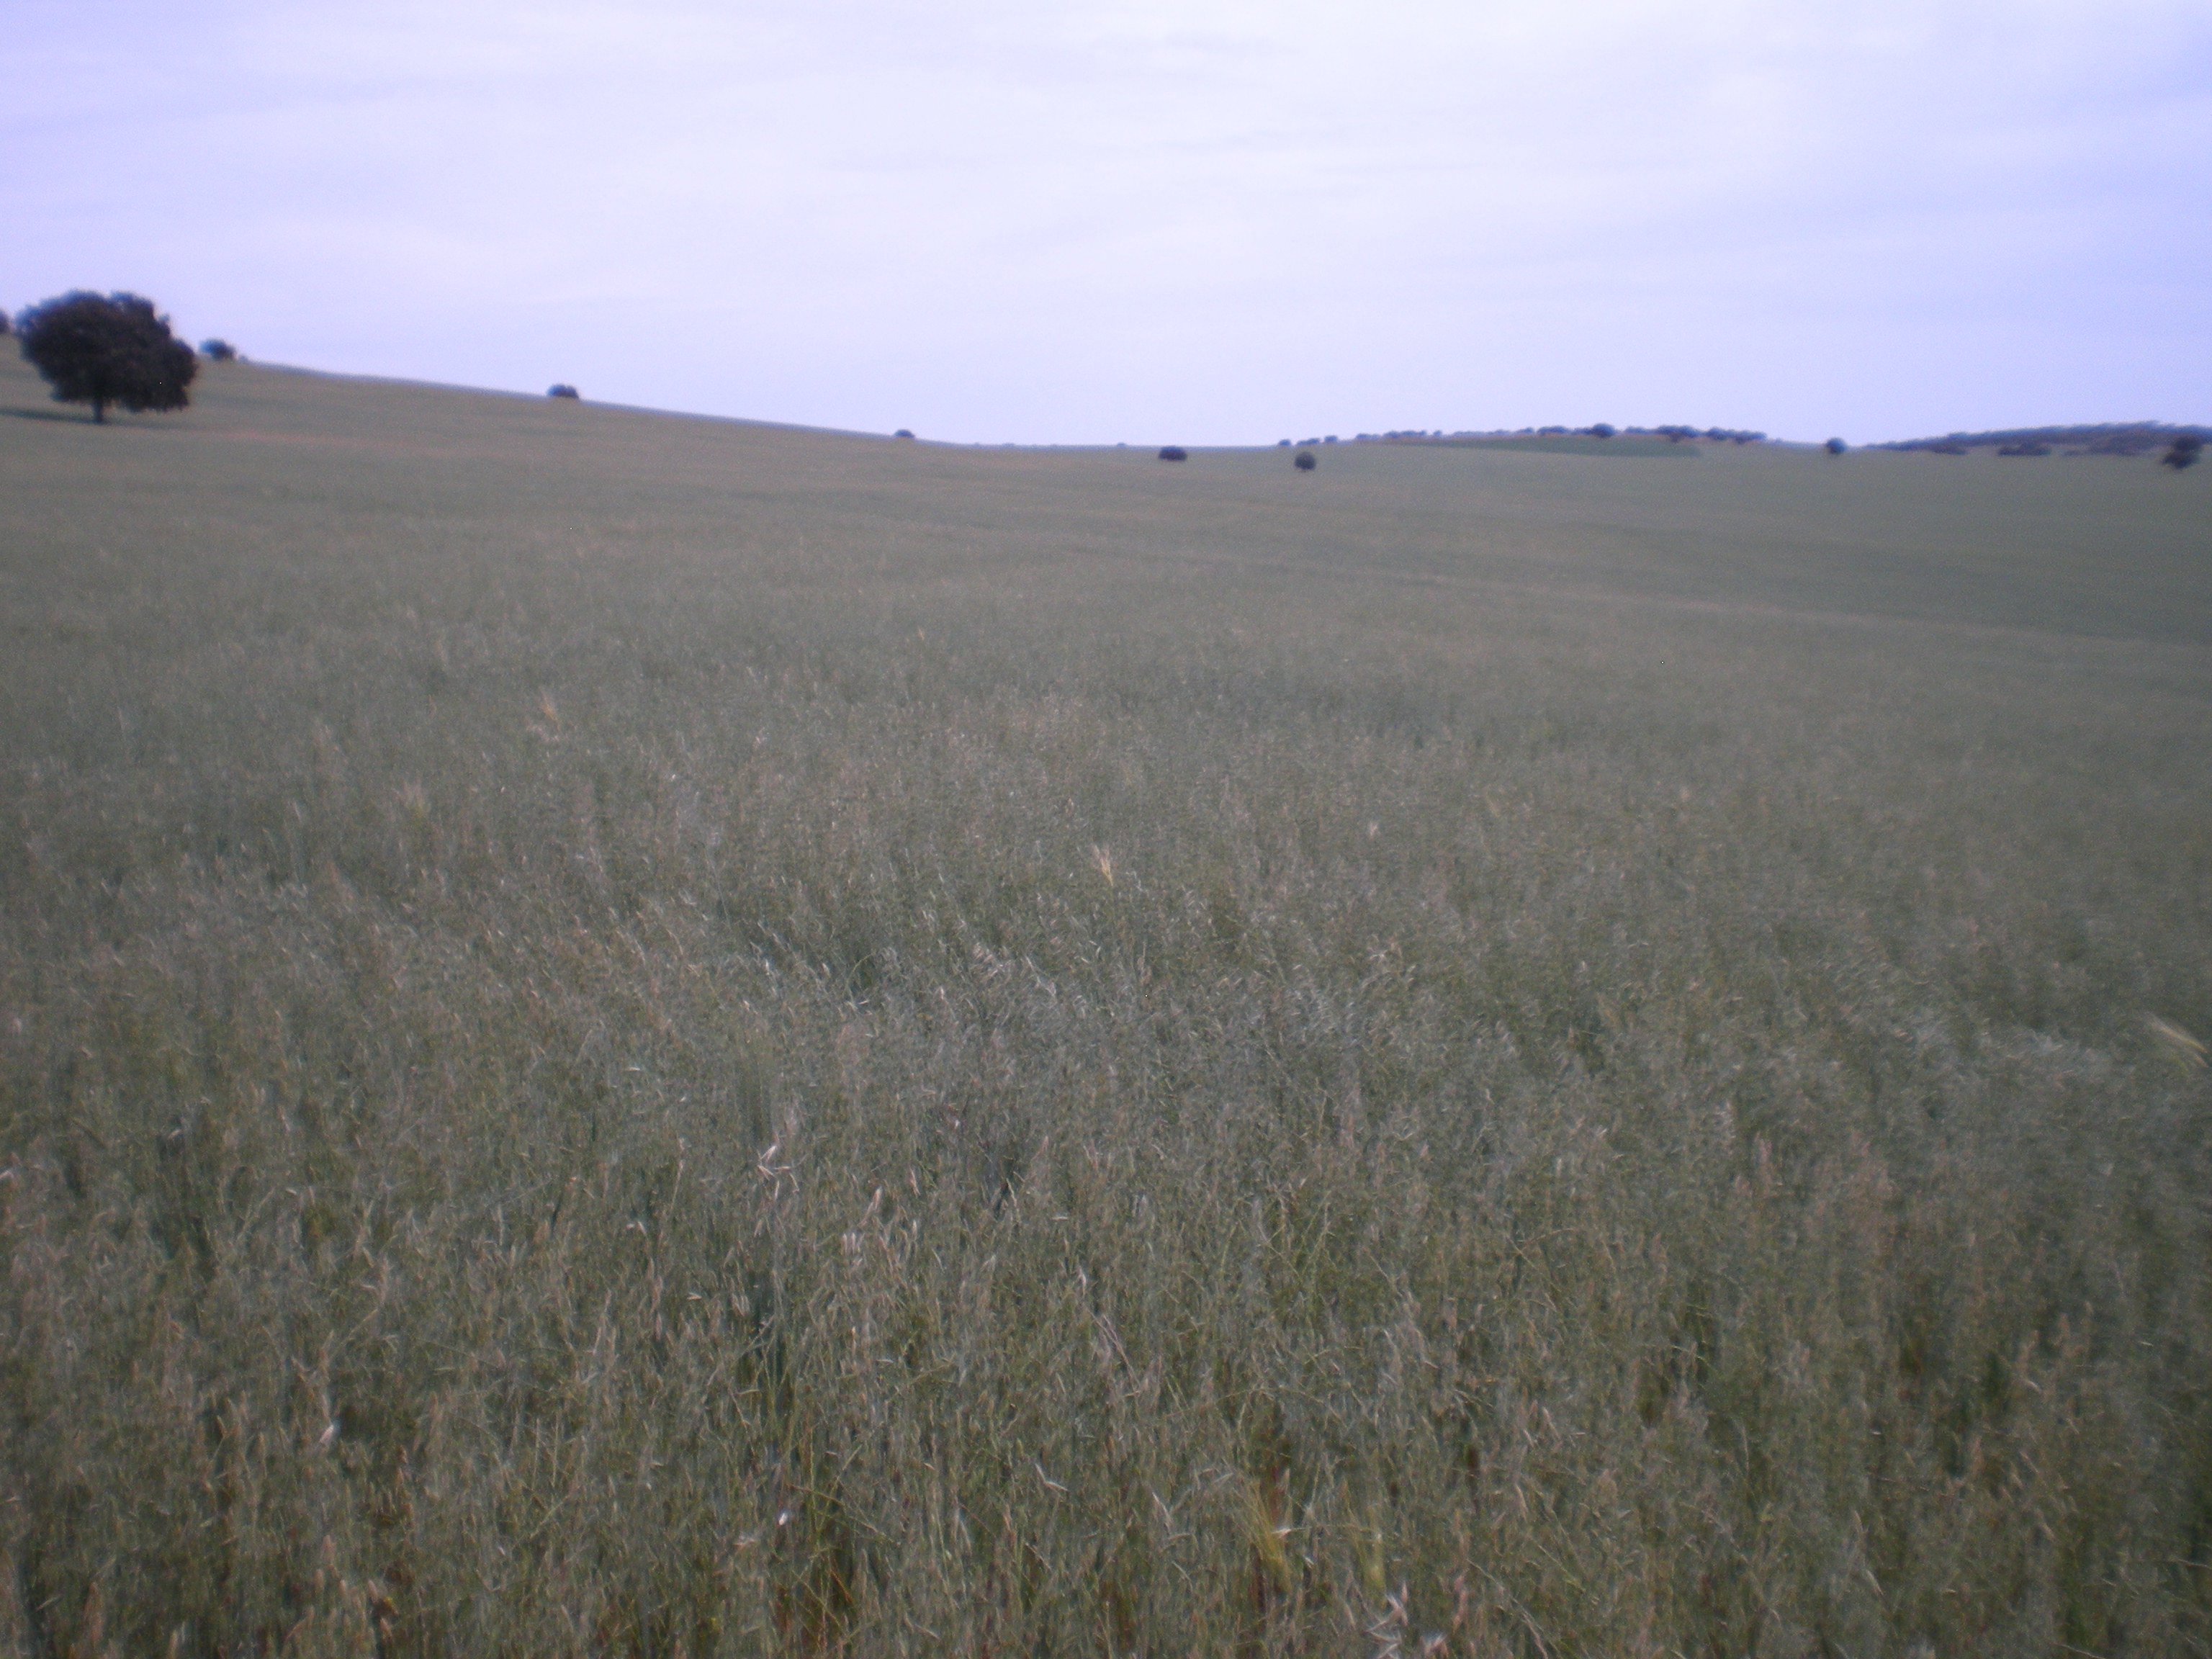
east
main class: Cropland
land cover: Oats
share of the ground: > 75 %
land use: Agriculture (excluding fallow land and kitchen gardens)
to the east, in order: Oats
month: May
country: ES
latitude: 38.7088
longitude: -3.2217
